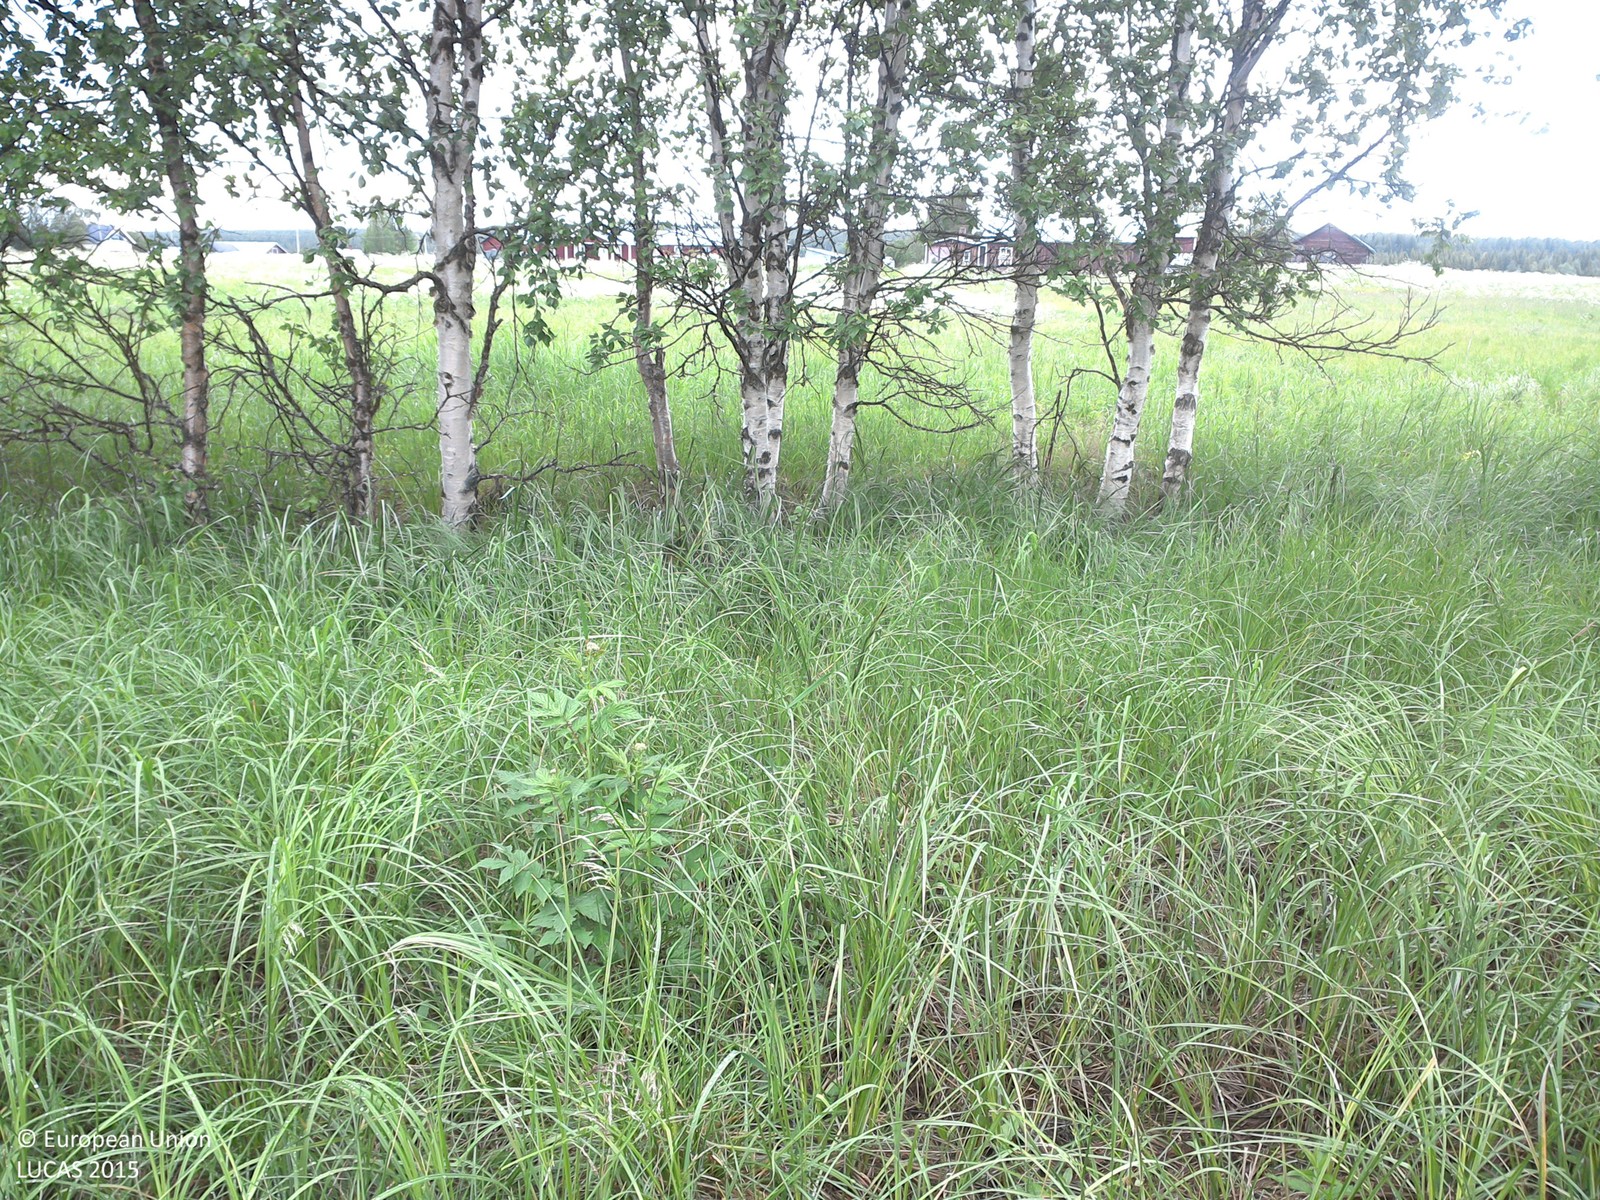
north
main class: Grassland
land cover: Grassland without tree/shrub cover
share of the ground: > 75 %
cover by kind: herbaceous plants 100 %
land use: Agriculture (excluding fallow land and kitchen gardens)
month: July
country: SE
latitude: 66.9155
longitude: 23.6707
